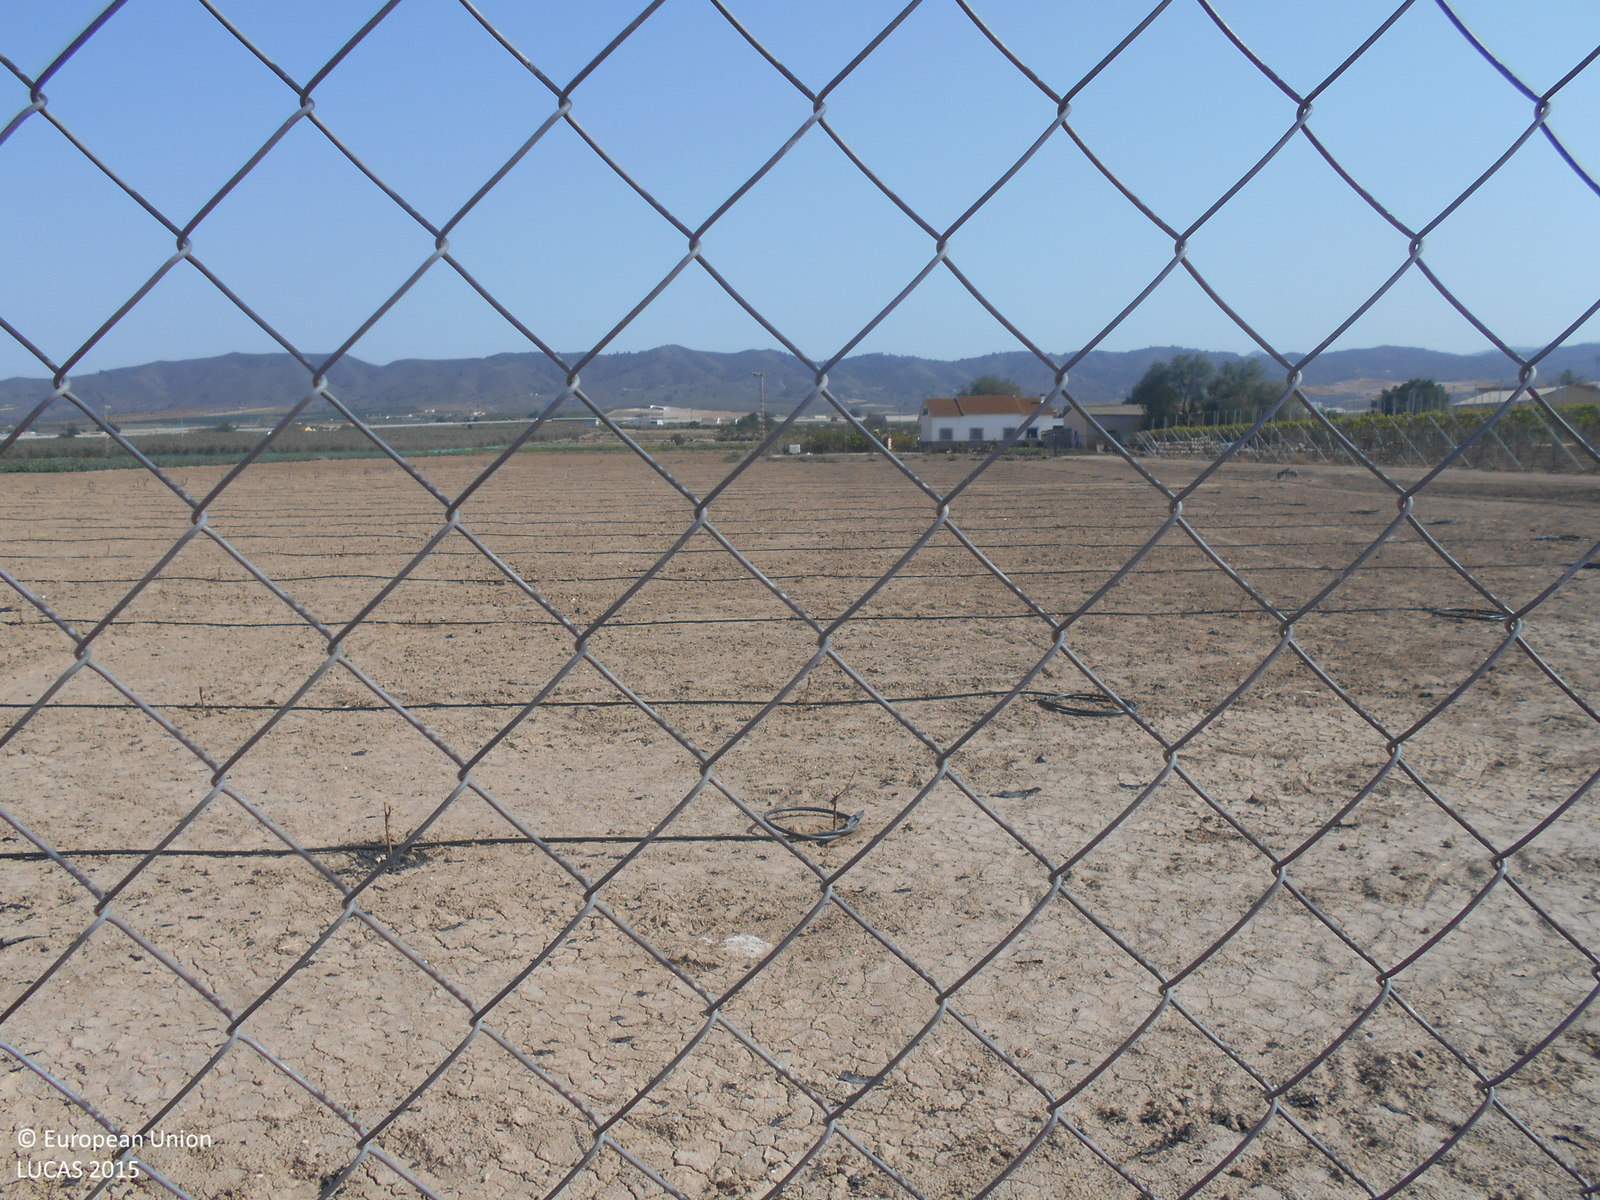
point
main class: Cropland
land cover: Vineyards
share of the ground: 25 - 50 %
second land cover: Other bare soil
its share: > 75 %
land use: Agriculture (excluding fallow land and kitchen gardens)
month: April
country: ES
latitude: 37.7041
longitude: -1.5174
